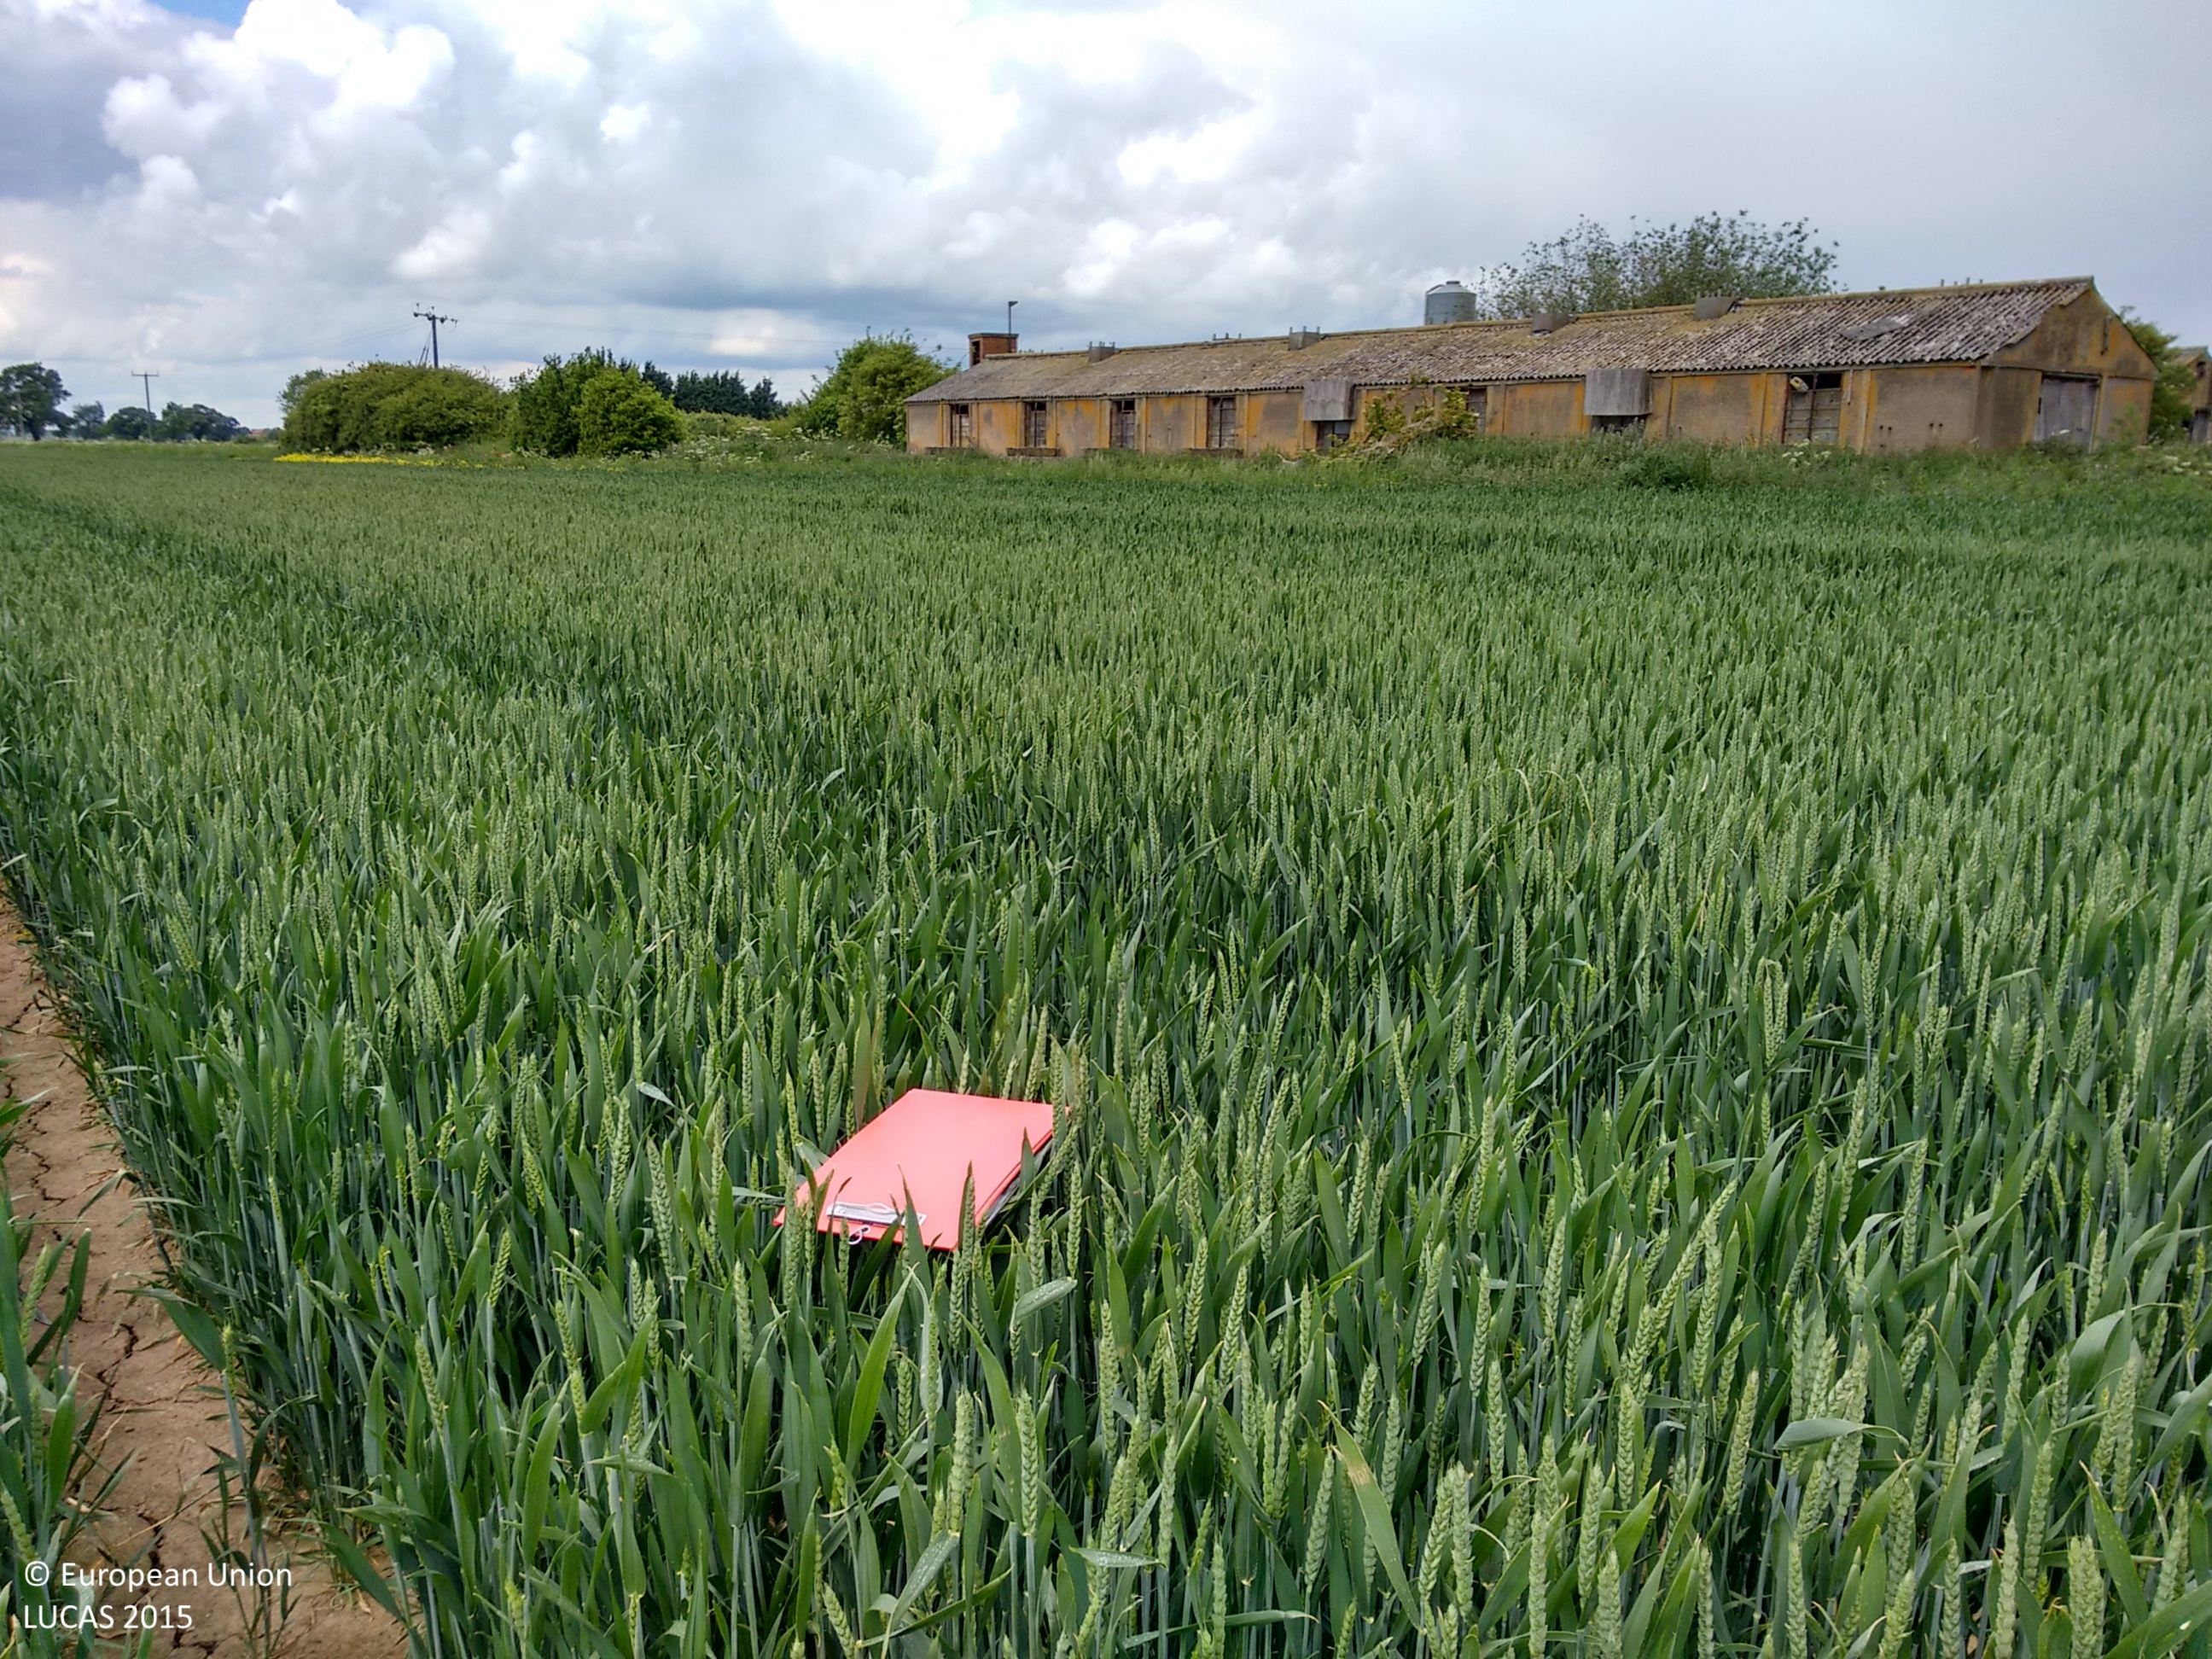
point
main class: Cropland
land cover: Common wheat
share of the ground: > 75 %
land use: Agriculture (excluding fallow land and kitchen gardens)
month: June
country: GB
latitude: 53.8852
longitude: -1.1354
